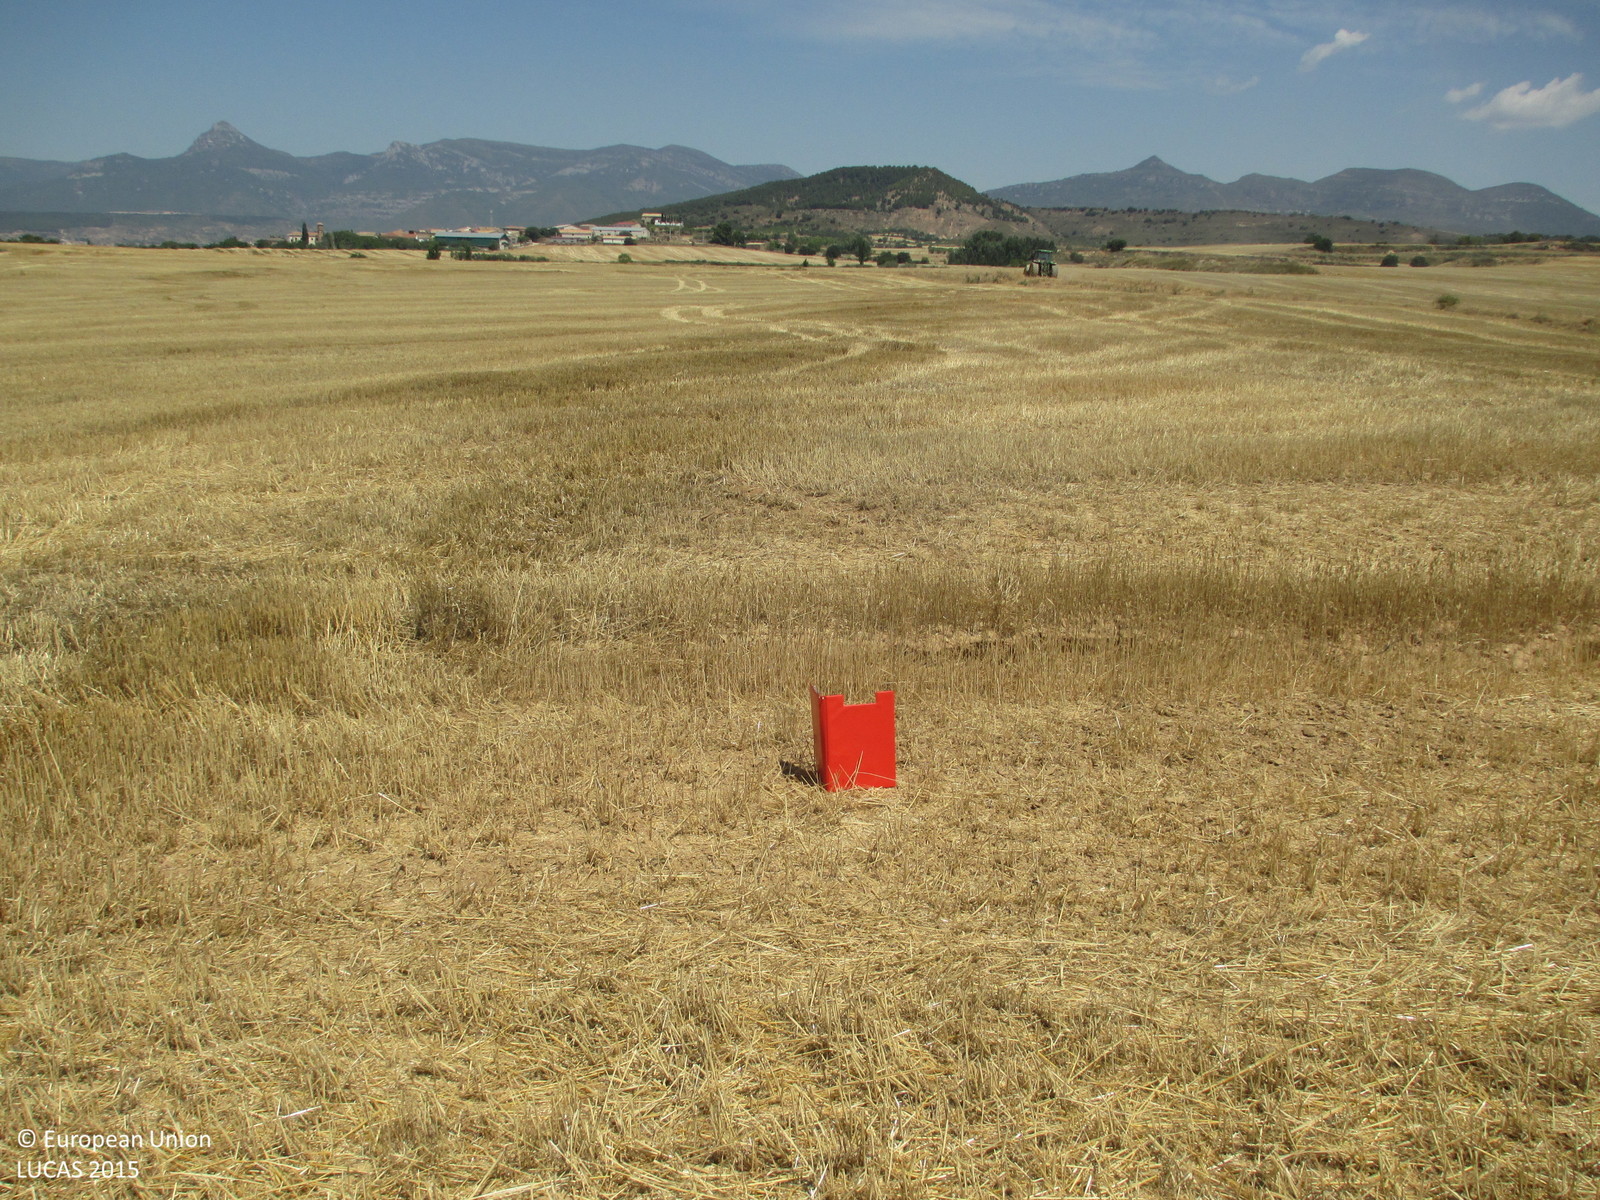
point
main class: Cropland
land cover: Common wheat
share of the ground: < 10 %
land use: Agriculture (excluding fallow land and kitchen gardens)
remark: Harvested field
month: June
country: ES
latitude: 42.2054
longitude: -0.4273
